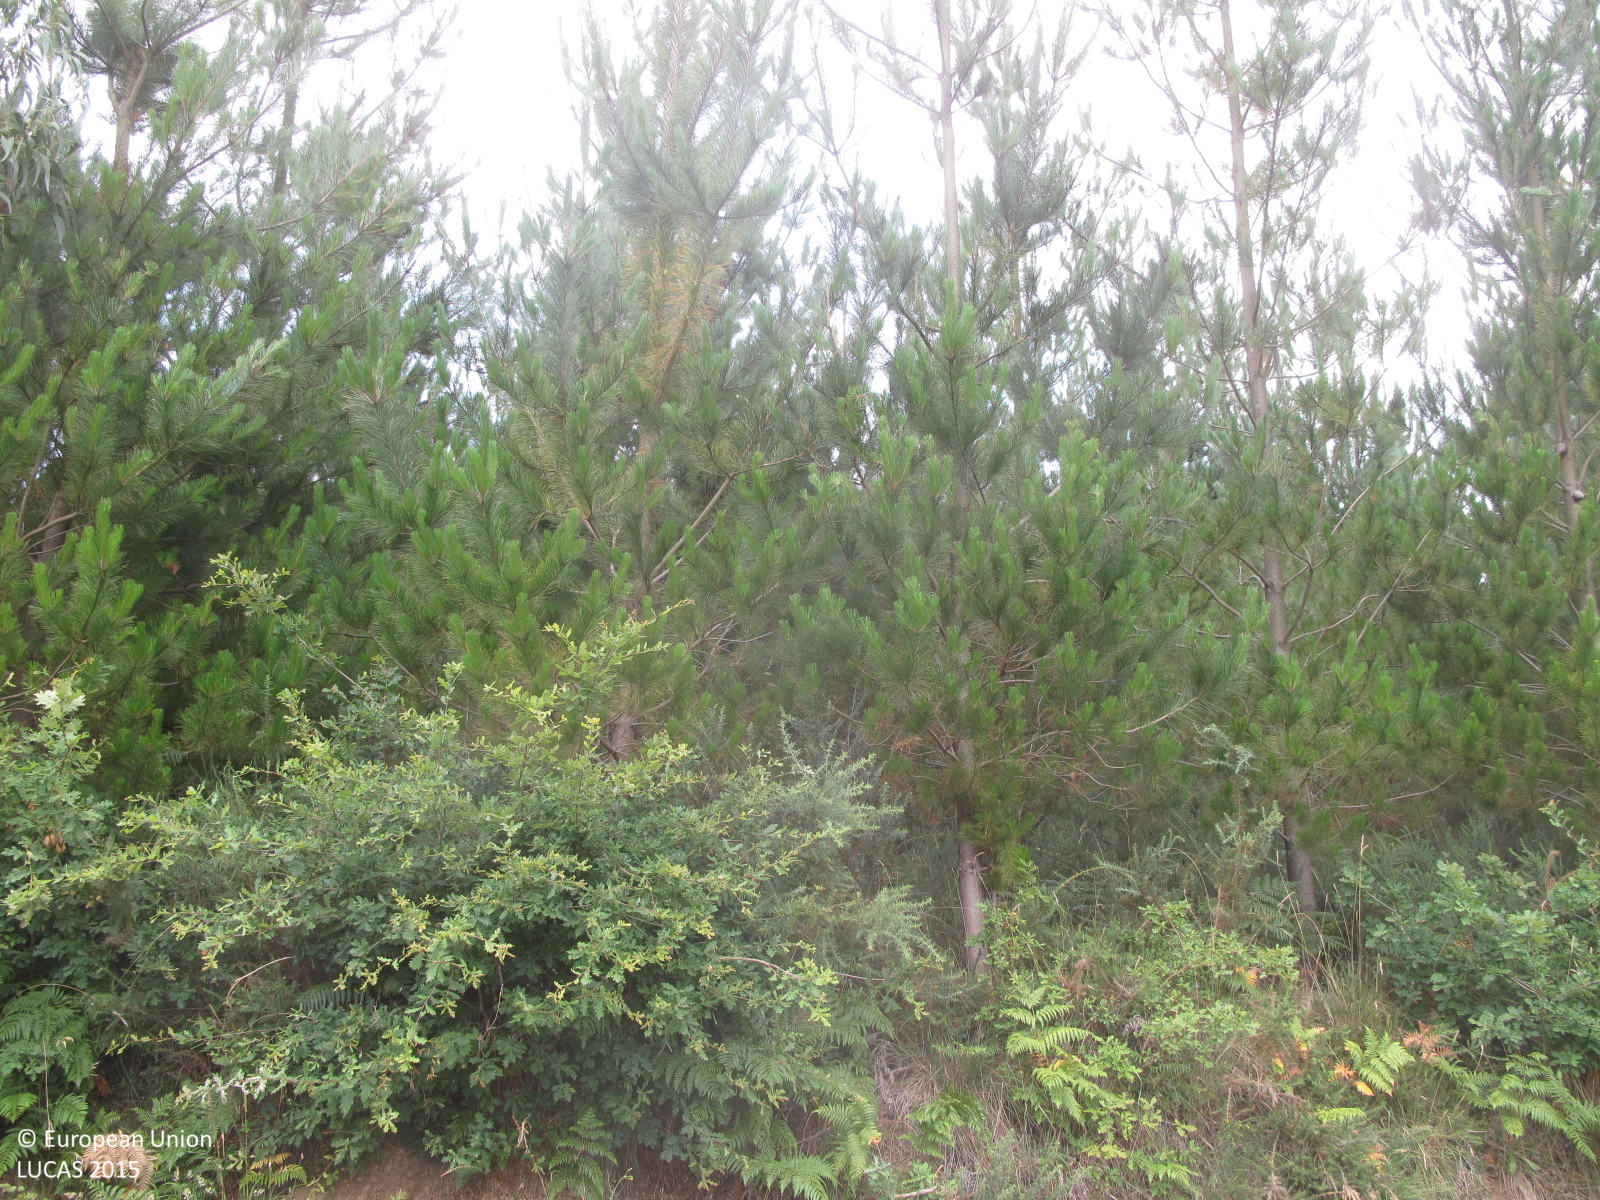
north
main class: Grassland
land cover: Grassland with sparse tree/shrub cover
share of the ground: > 75 %
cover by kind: herbaceous plants 95 %, broadleaved forest trees 5 %
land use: Residential
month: July
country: ES
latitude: 43.2996
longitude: -8.2842
